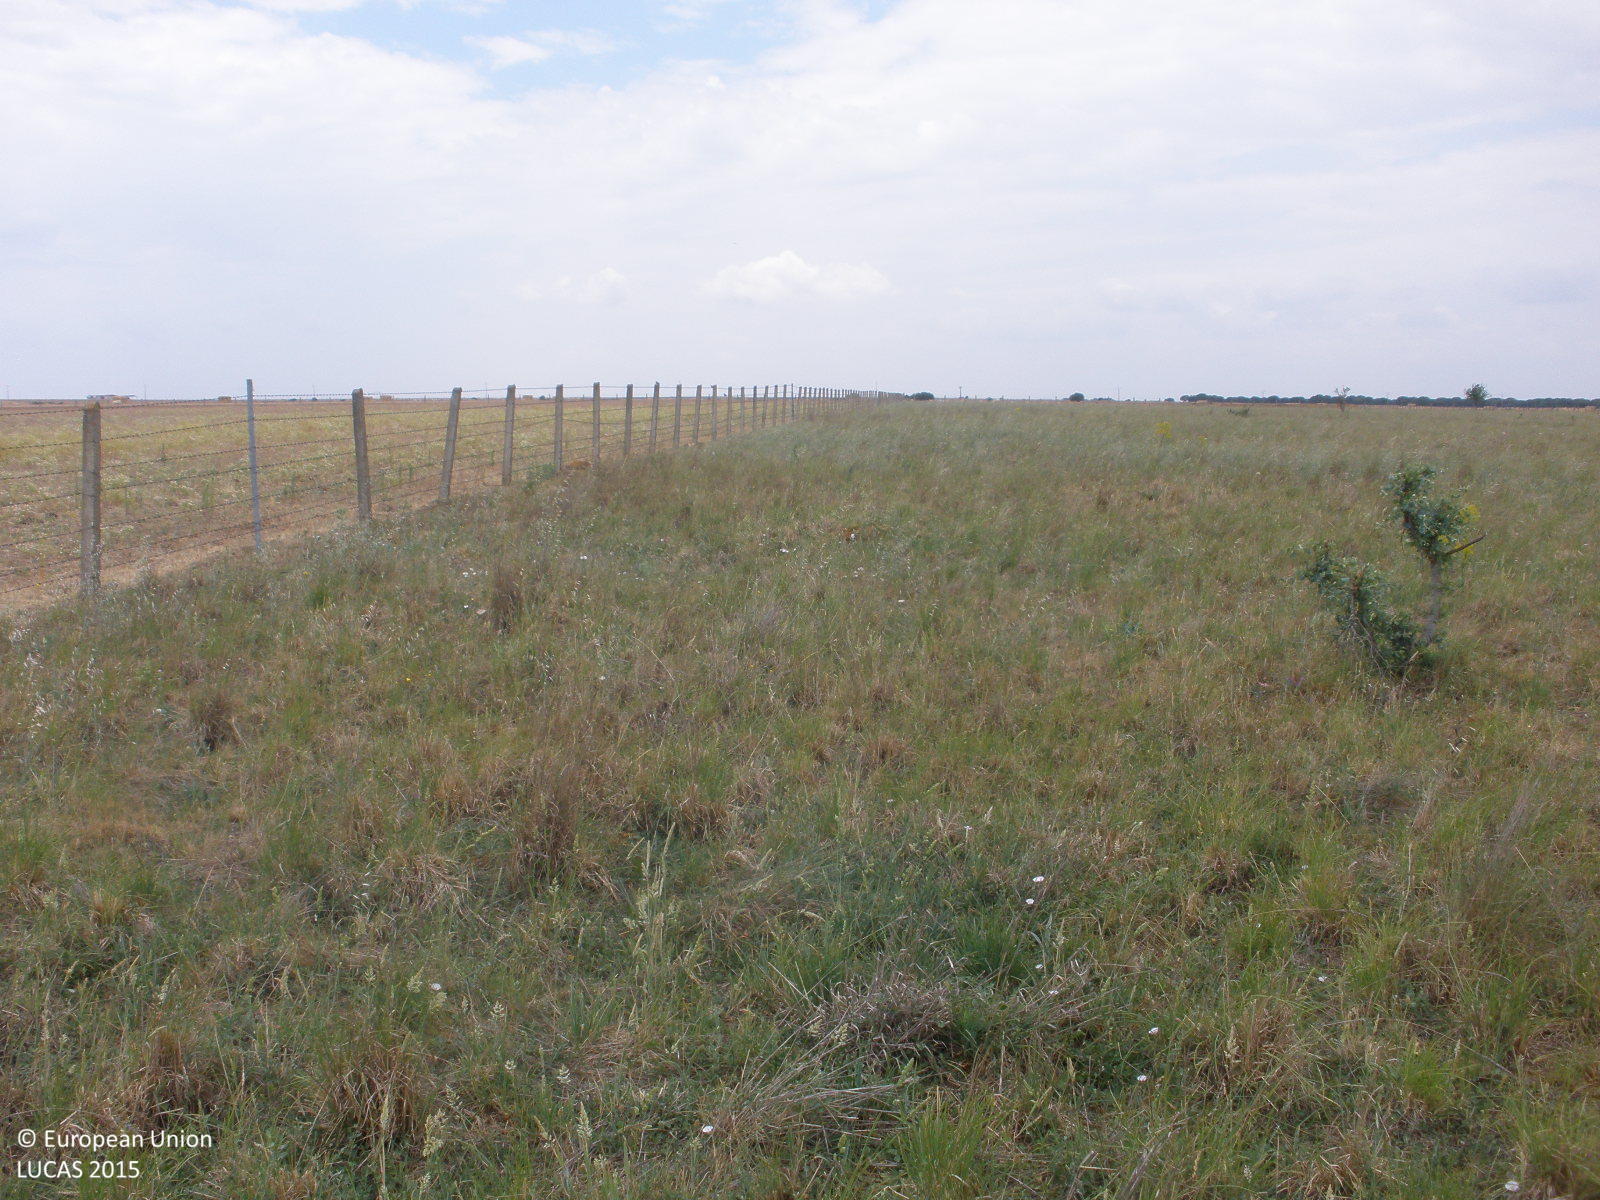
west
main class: Grassland
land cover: Grassland without tree/shrub cover
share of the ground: > 75 %
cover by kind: herbaceous plants 100 %
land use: Agriculture (excluding fallow land and kitchen gardens)
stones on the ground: 25 - 50 %
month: June
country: ES
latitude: 40.6739
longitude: -6.1121
